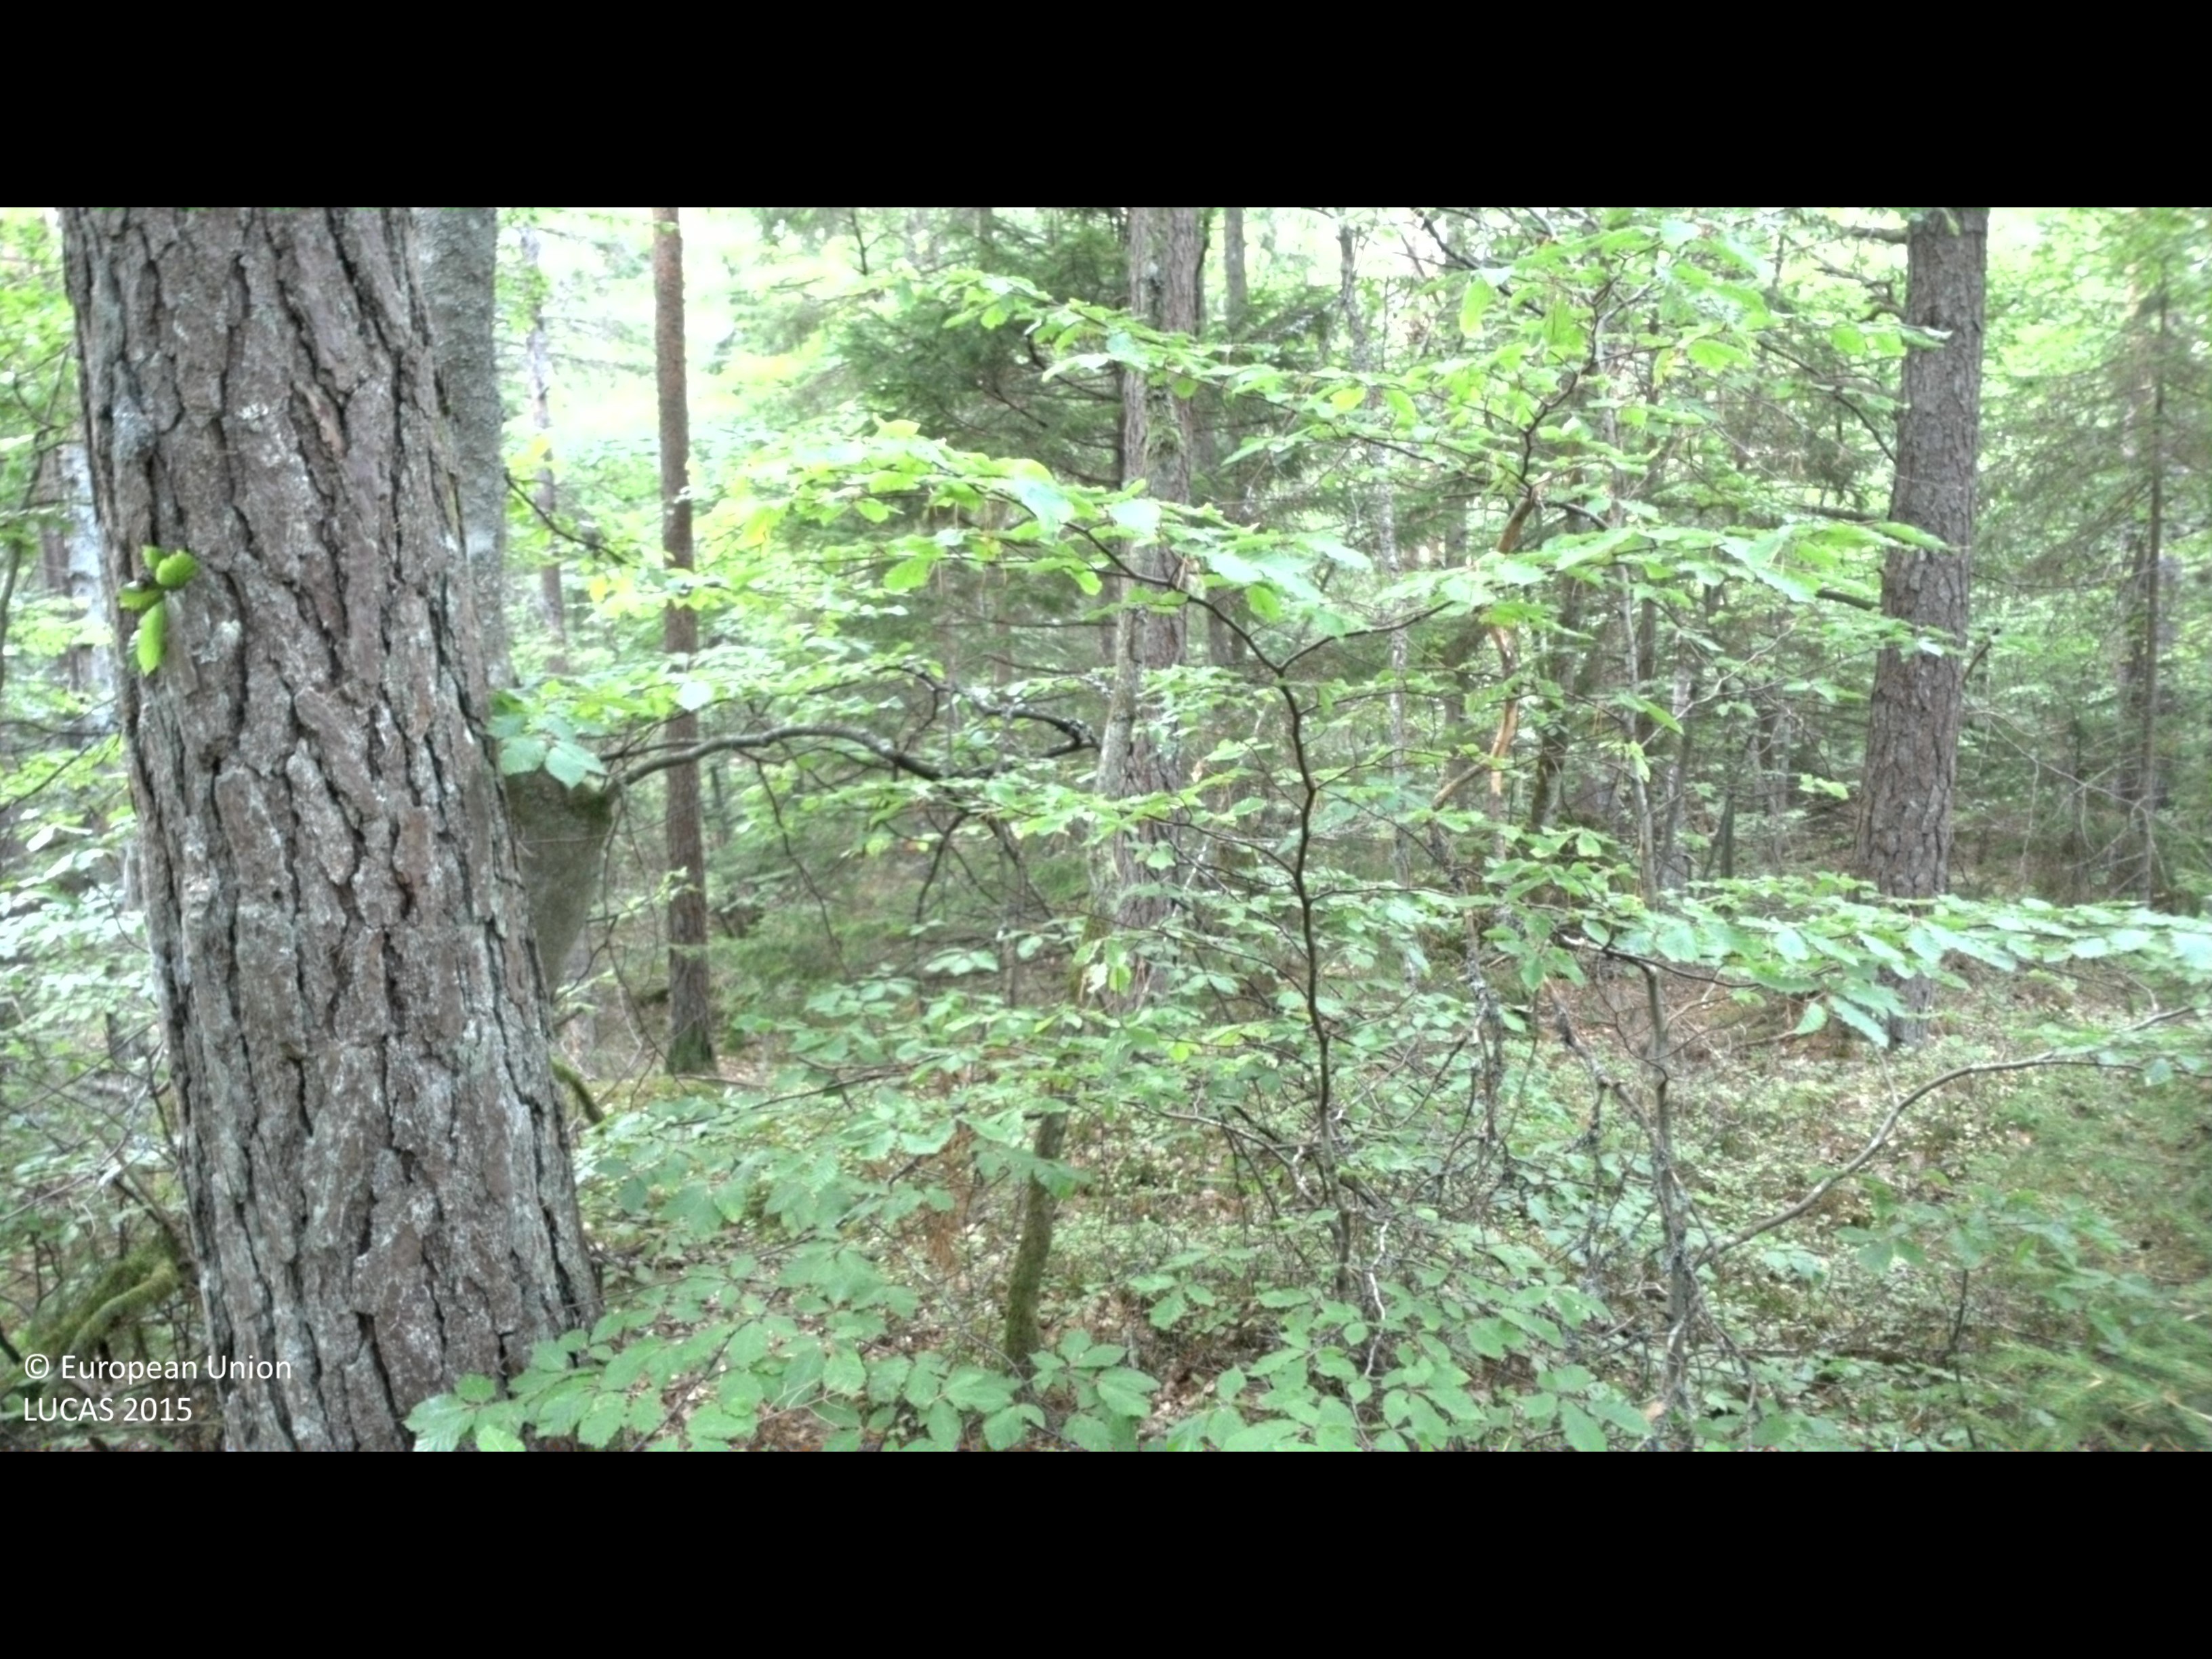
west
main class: Woodland
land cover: Pine dominated mixed woodland
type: hemiboreal forest and nemoral coniferous forest and mixed broadleaved-coniferous forest
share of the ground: 50 - 75 %
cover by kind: coniferous forest trees 50 %, broadleaved forest trees 20 %, shrubs 20 %, lichens and mosses 10 %
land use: Forestry
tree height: > 5 m
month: September
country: SE
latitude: 56.2877
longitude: 15.0228
